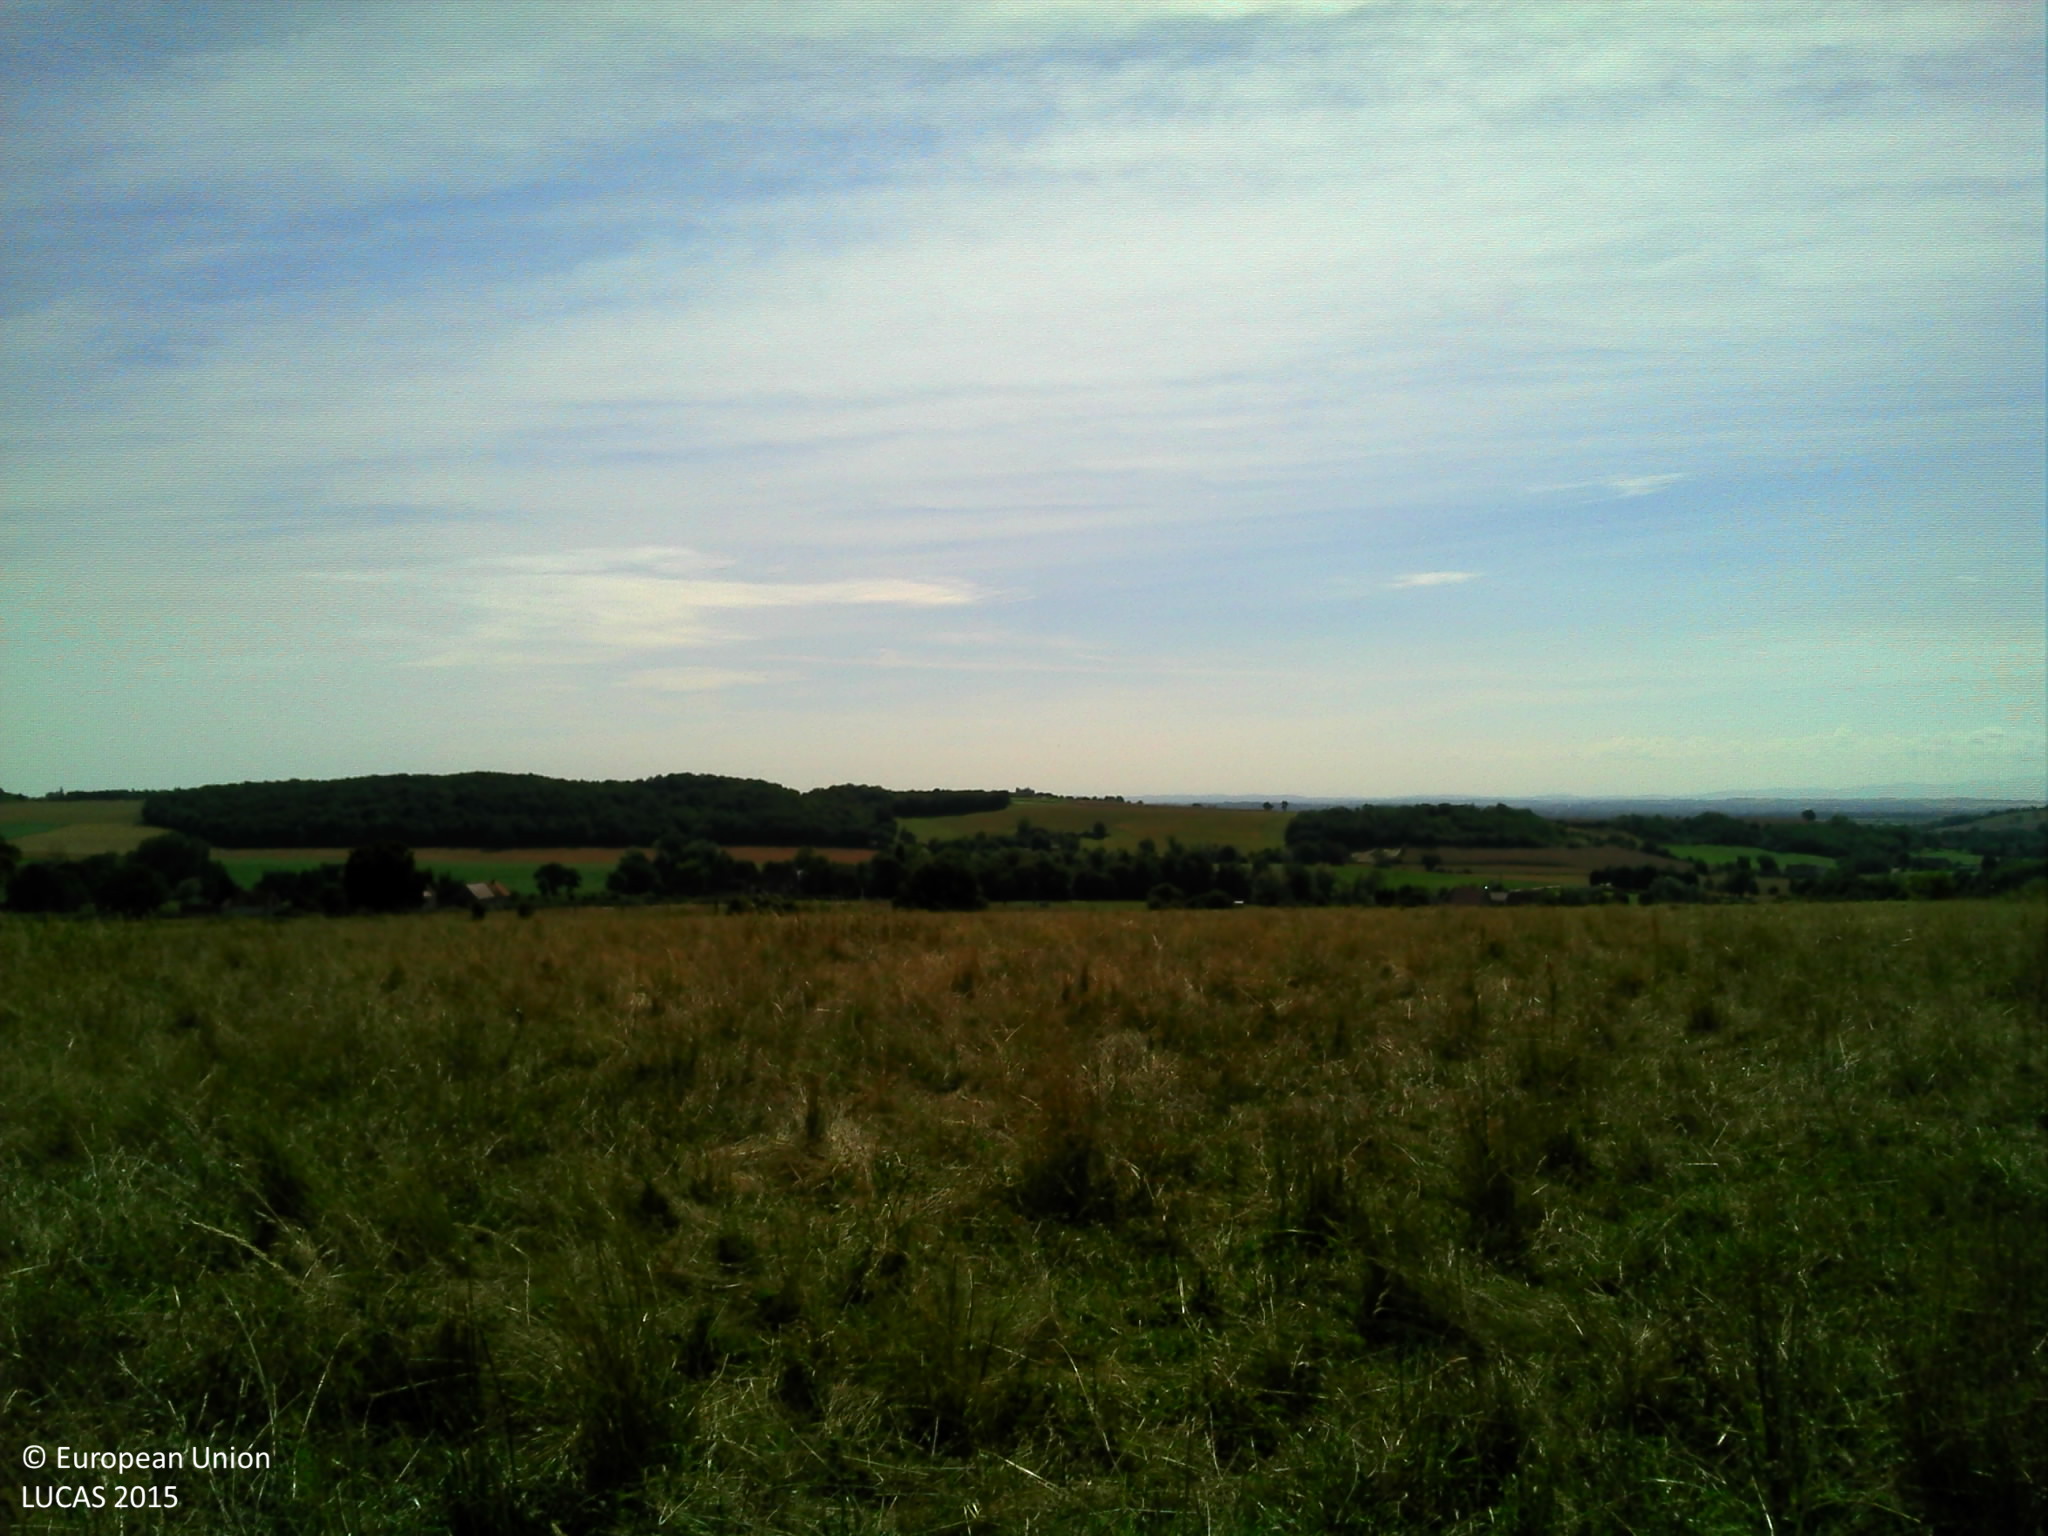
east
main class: Grassland
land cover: Grassland without tree/shrub cover
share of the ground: > 75 %
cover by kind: herbaceous plants 100 %
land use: Agriculture (excluding fallow land and kitchen gardens)
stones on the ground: < 10 %
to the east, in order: Grassland without tree/shrub cover; Fences; Ditches and canals; Grass margins; Tracks; Grass margins; Common wheat
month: June
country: FR
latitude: 46.3550
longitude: 3.2537
